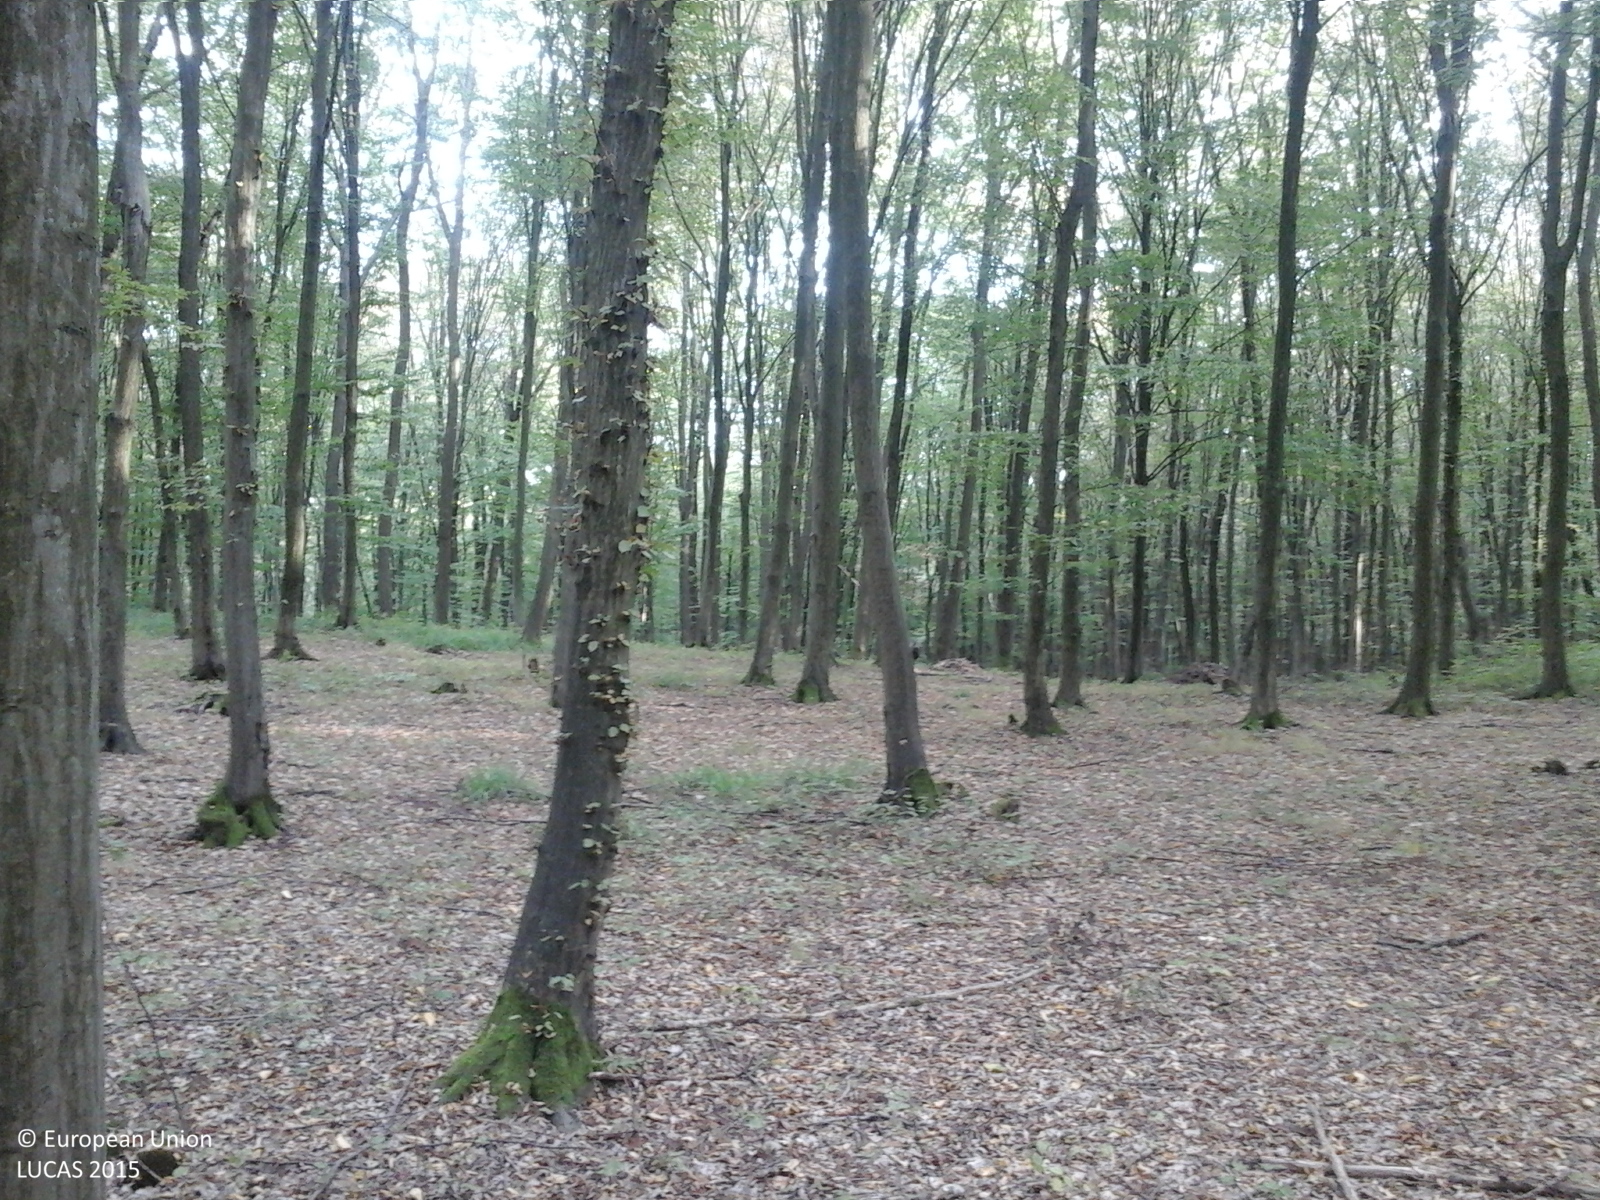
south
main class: Woodland
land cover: Broadleaved woodland
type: beech forest
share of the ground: > 75 %
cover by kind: broadleaved forest trees 100 %
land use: Forestry
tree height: > 5 m
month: September
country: RO
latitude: 47.6240
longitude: 23.3653
